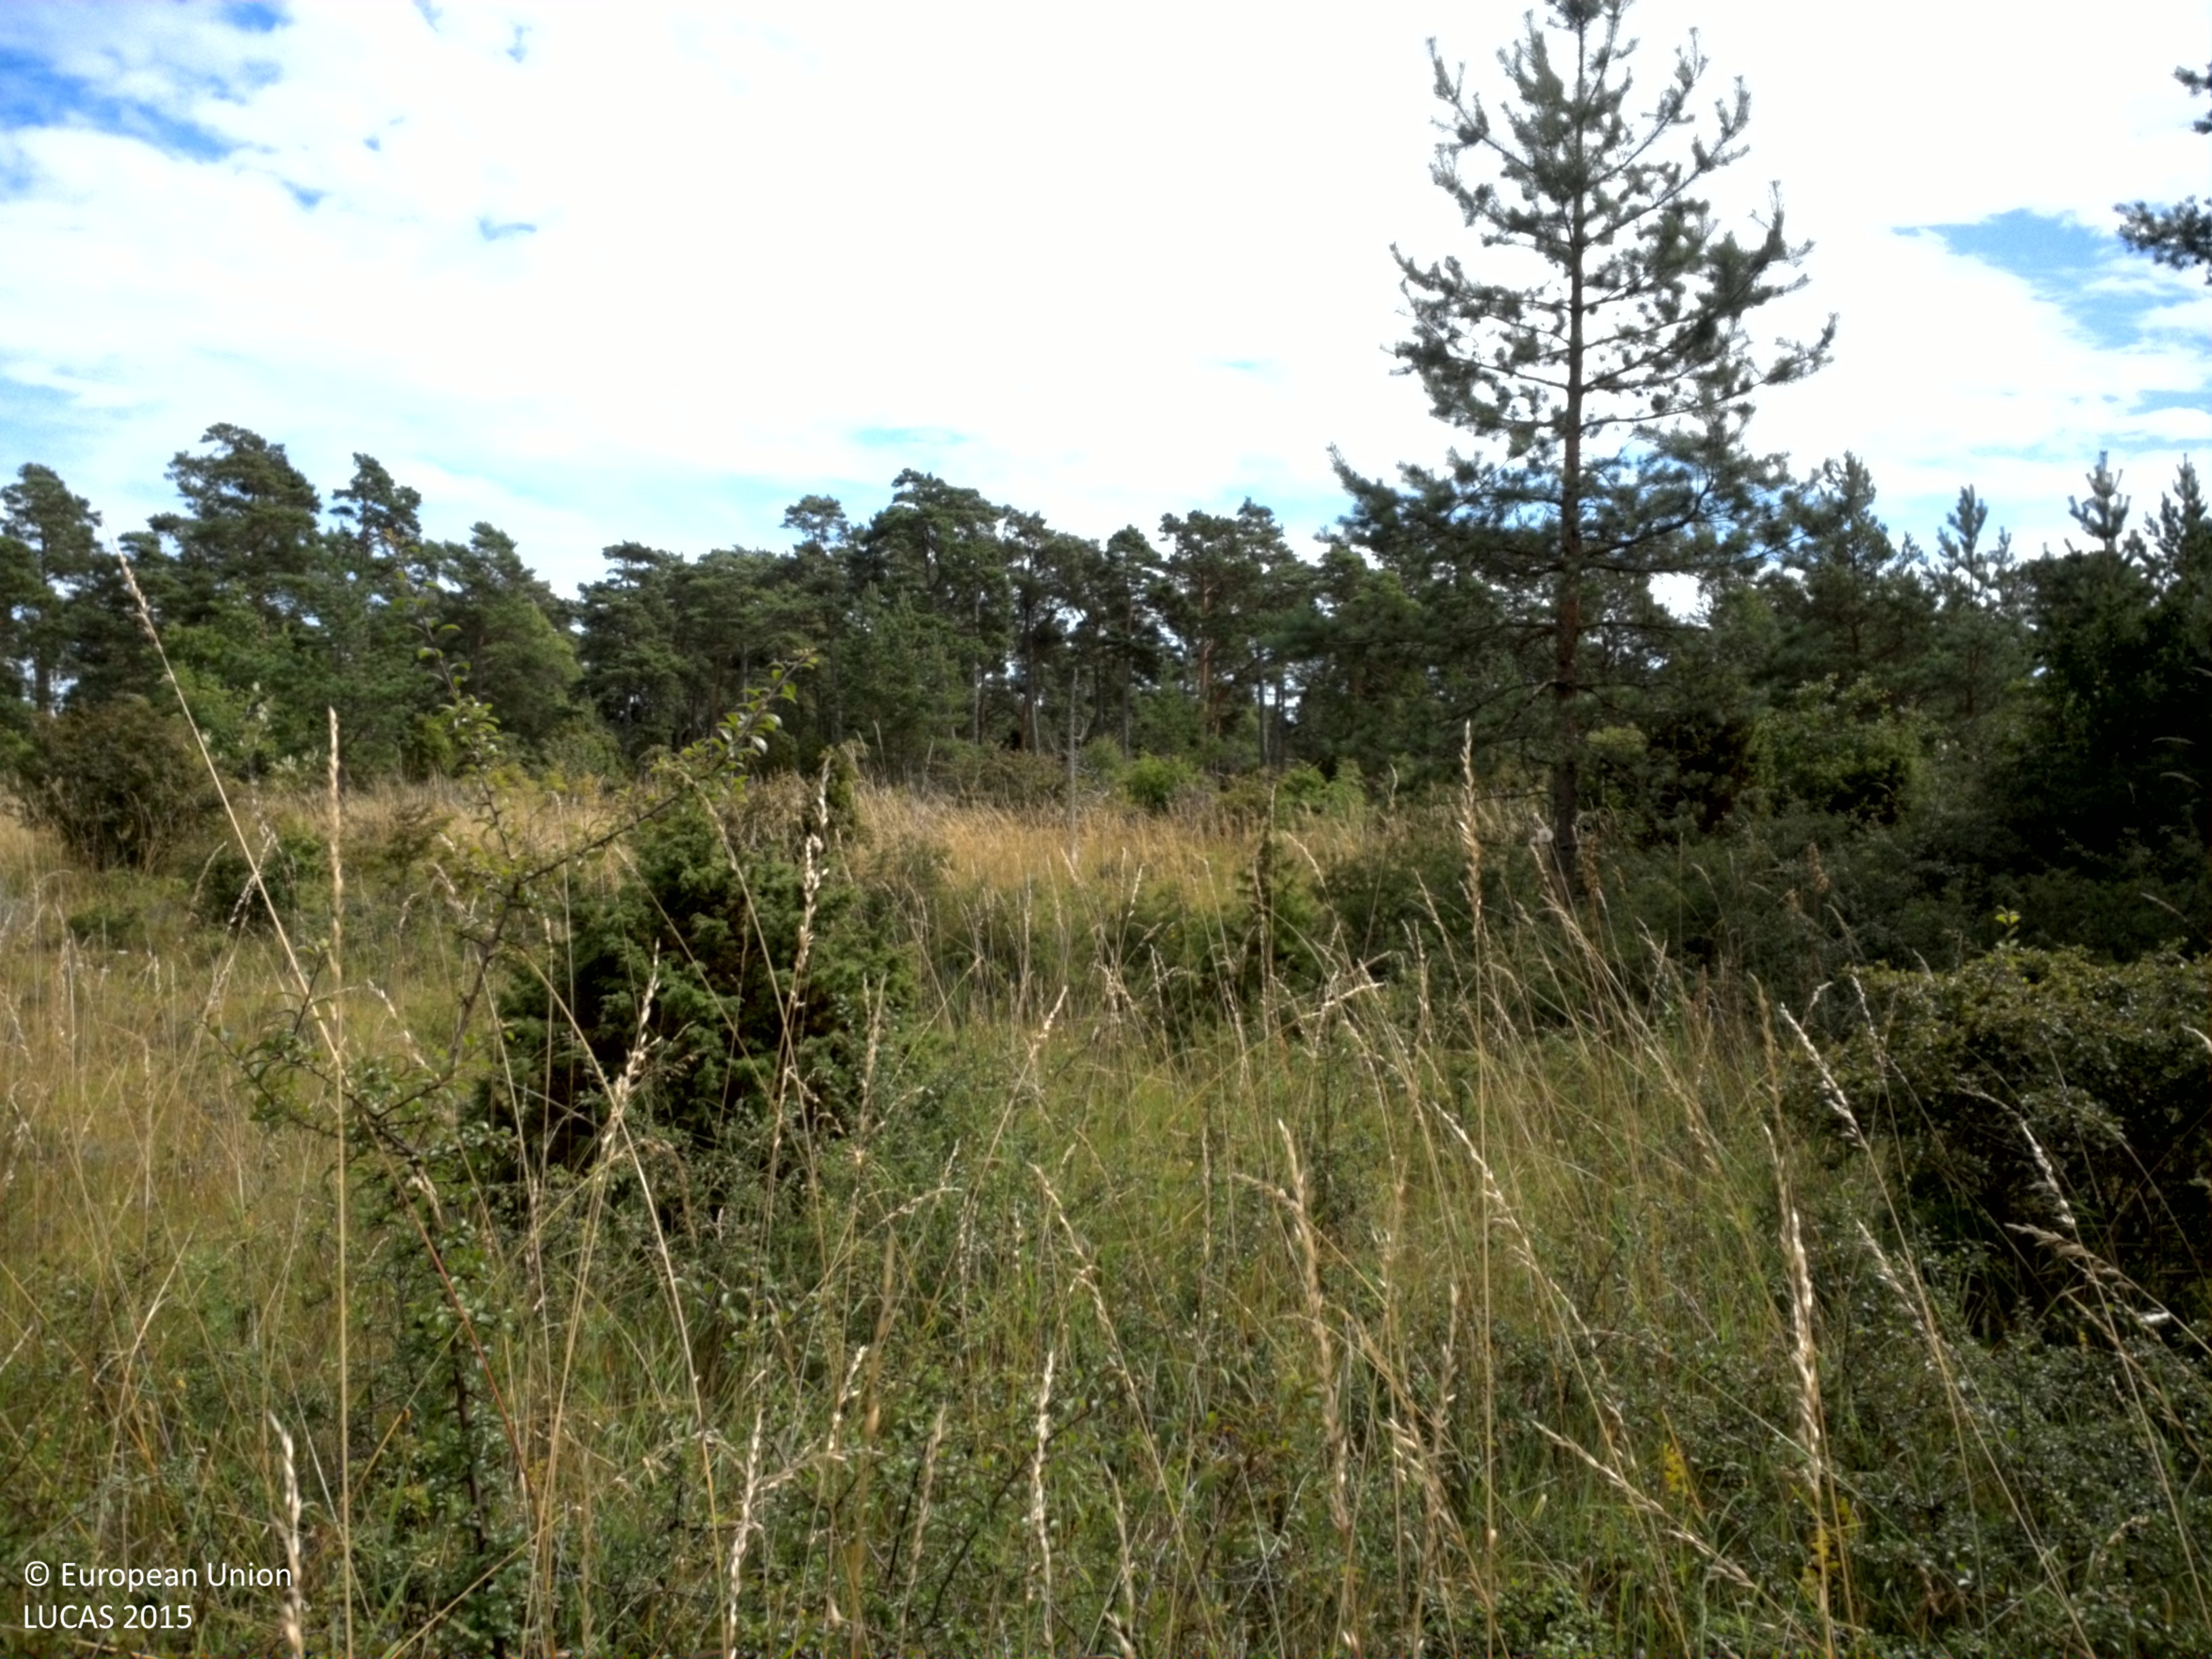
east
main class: Woodland
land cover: Pine dominated coniferous woodland
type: hemiboreal forest and nemoral coniferous forest and mixed broadleaved-coniferous forest
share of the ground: 50 - 75 %
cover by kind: coniferous forest trees 50 %, herbaceous plants 35 %, shrubs 15 %
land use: Forestry
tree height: > 5 m
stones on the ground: < 10 %
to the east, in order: Pine dominated coniferous woodland; Shrubland with sparse tree cover; Fences; Pine dominated coniferous woodland
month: July
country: SE
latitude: 57.2728
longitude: 18.6175
